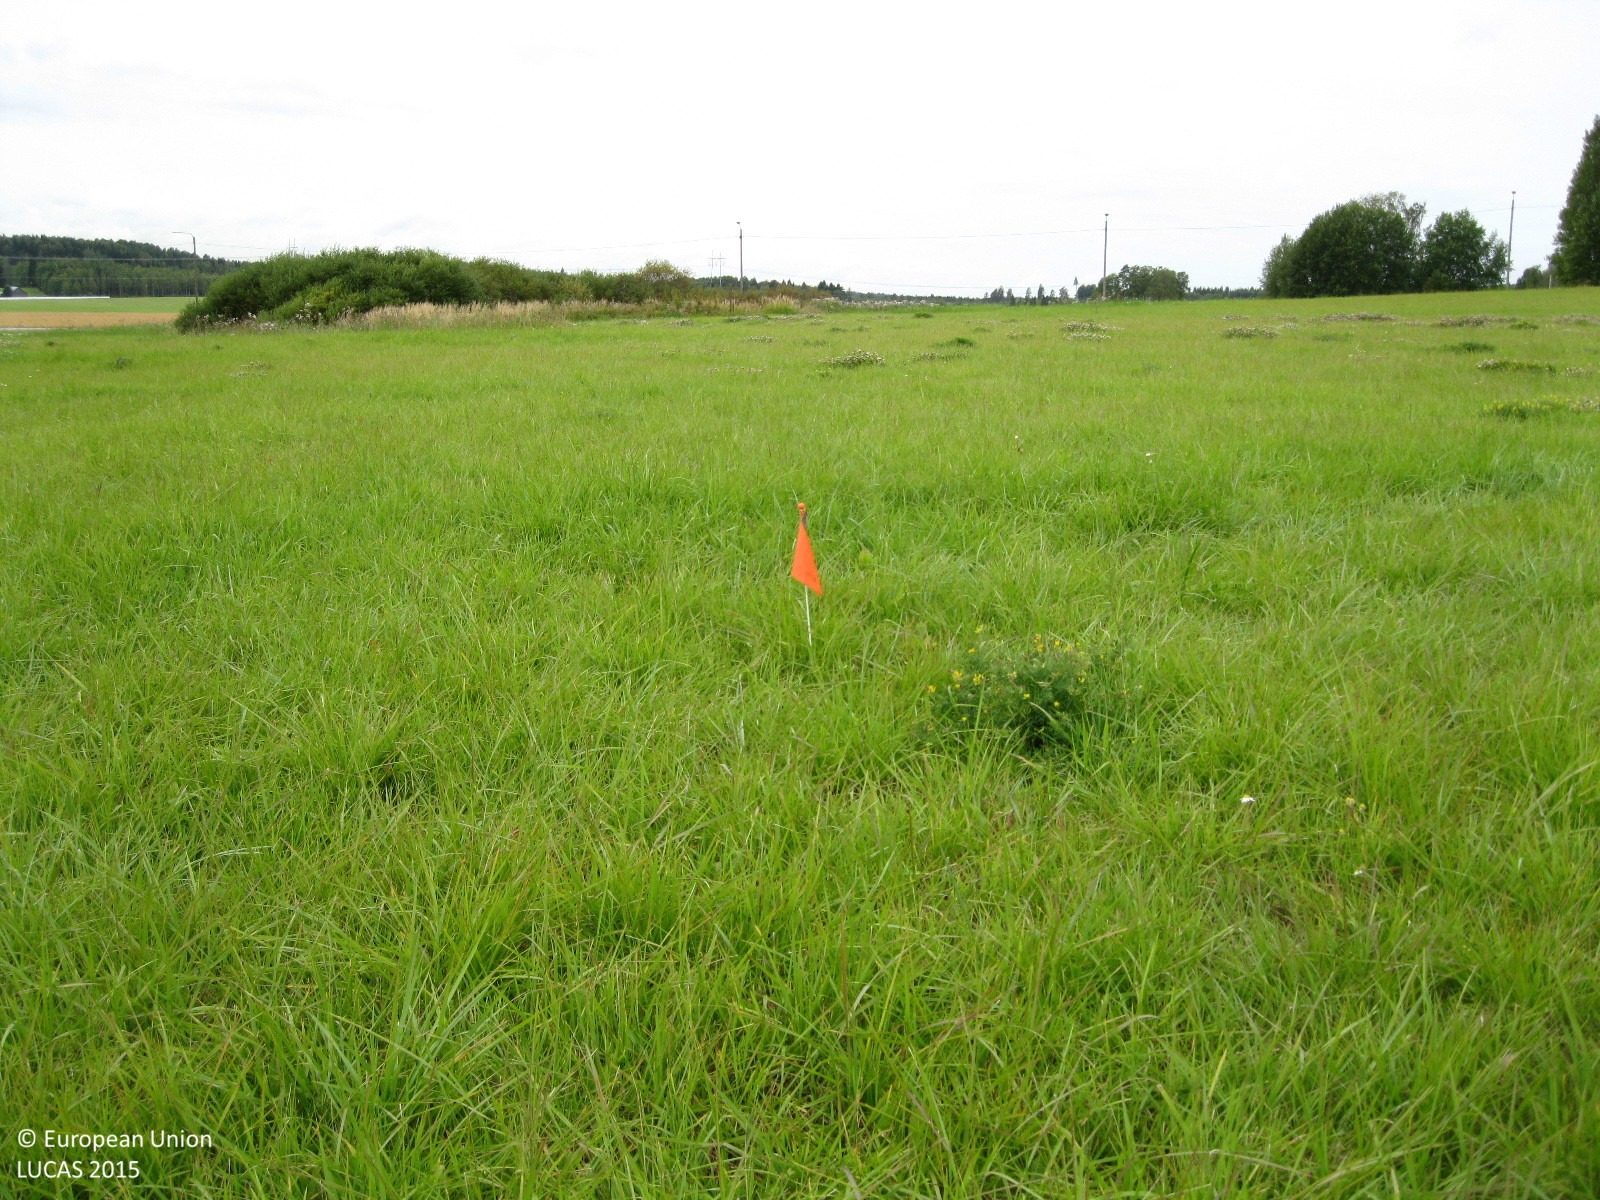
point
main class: Cropland
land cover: Temporary grasslands
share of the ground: > 75 %
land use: Agriculture (excluding fallow land and kitchen gardens)
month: September
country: FI
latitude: 60.4040
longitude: 24.7984
